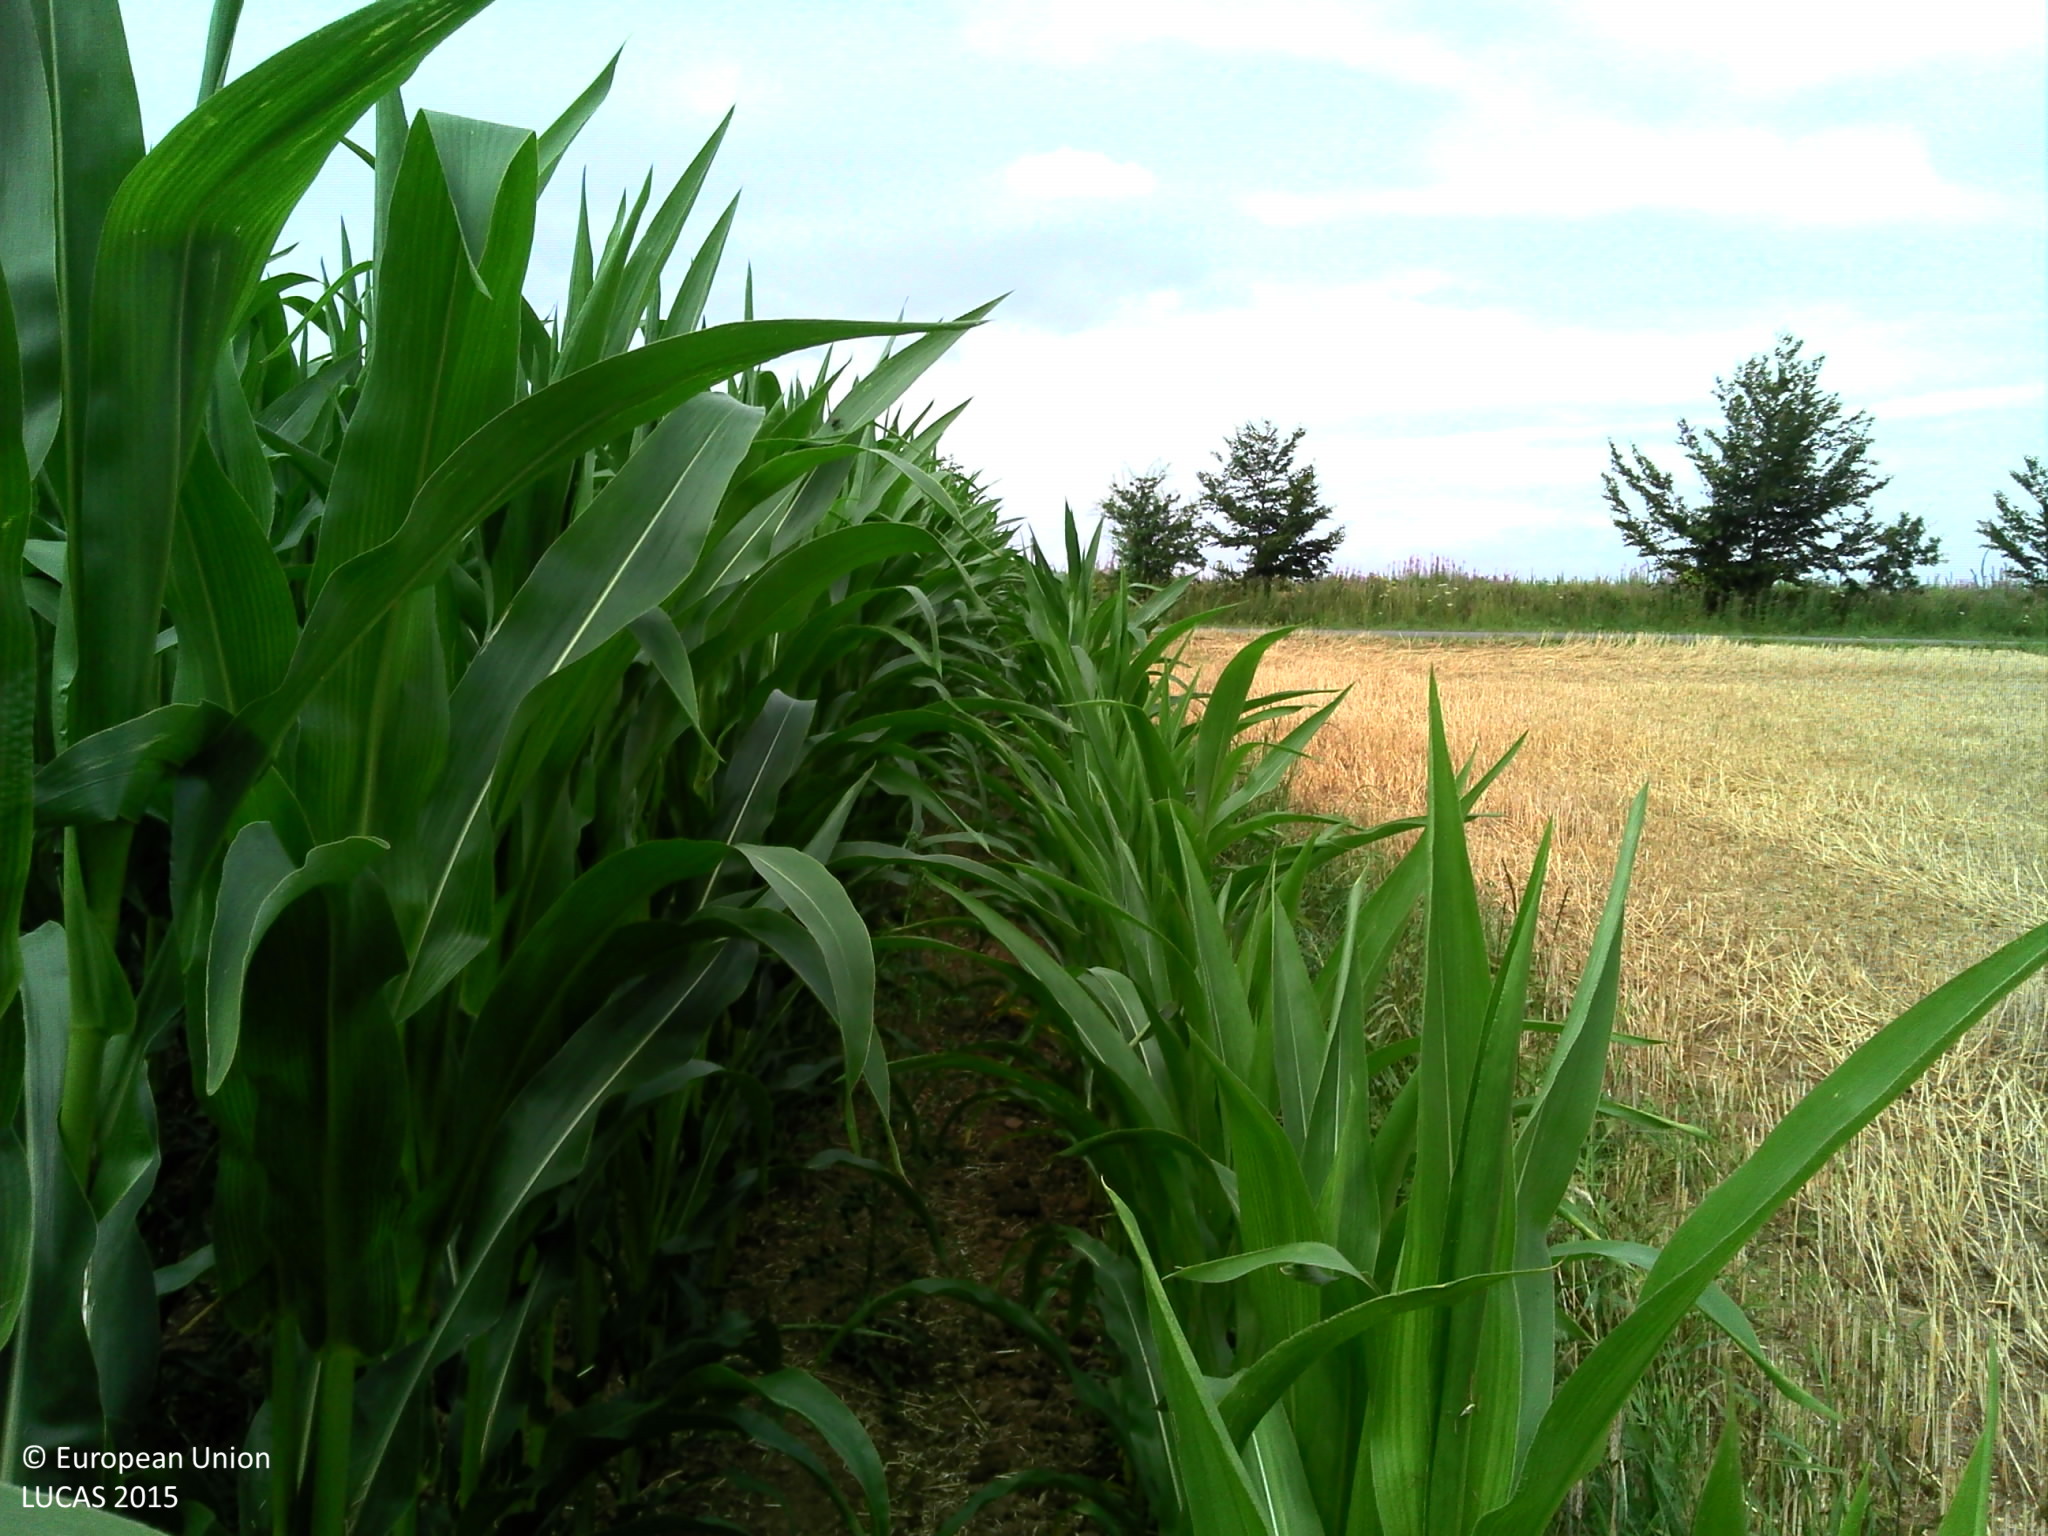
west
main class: Cropland
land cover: Maize
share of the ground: > 75 %
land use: Agriculture (excluding fallow land and kitchen gardens)
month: July
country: BE
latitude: 49.7908
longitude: 5.5395
